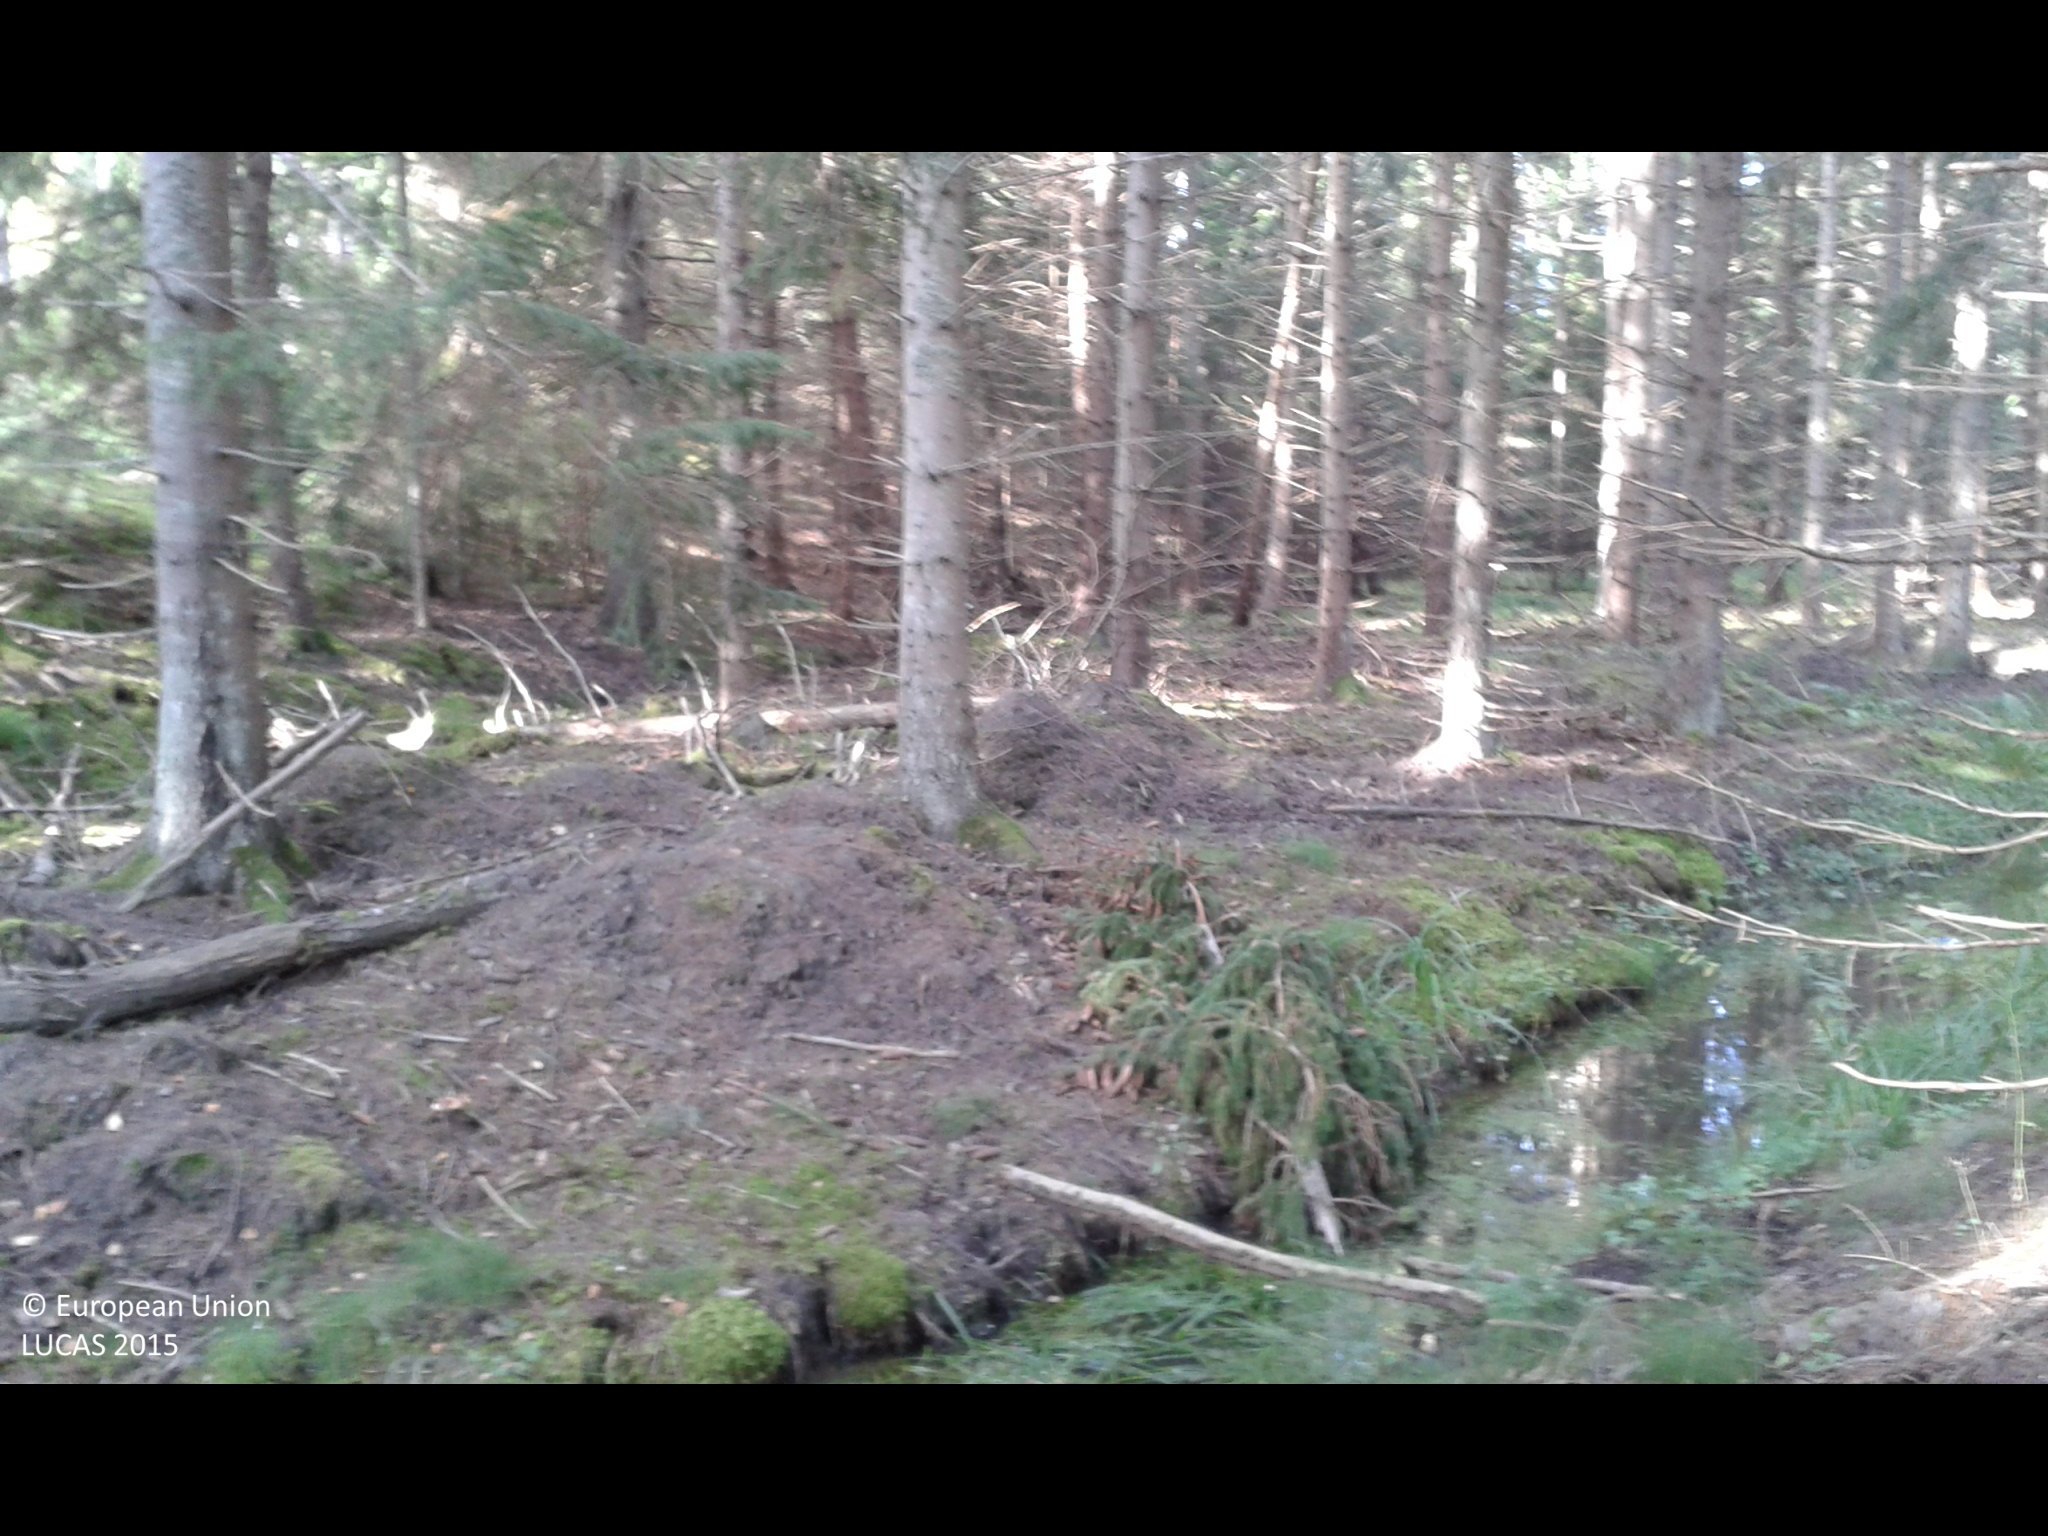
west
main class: Woodland
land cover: Spruce dominated coniferous woodland
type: boreal forest
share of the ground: > 75 %
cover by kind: coniferous forest trees 80 %, herbaceous plants 20 %
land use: Forestry
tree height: > 5 m
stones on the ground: < 10 %
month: October
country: SE
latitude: 58.9704
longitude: 17.4589
